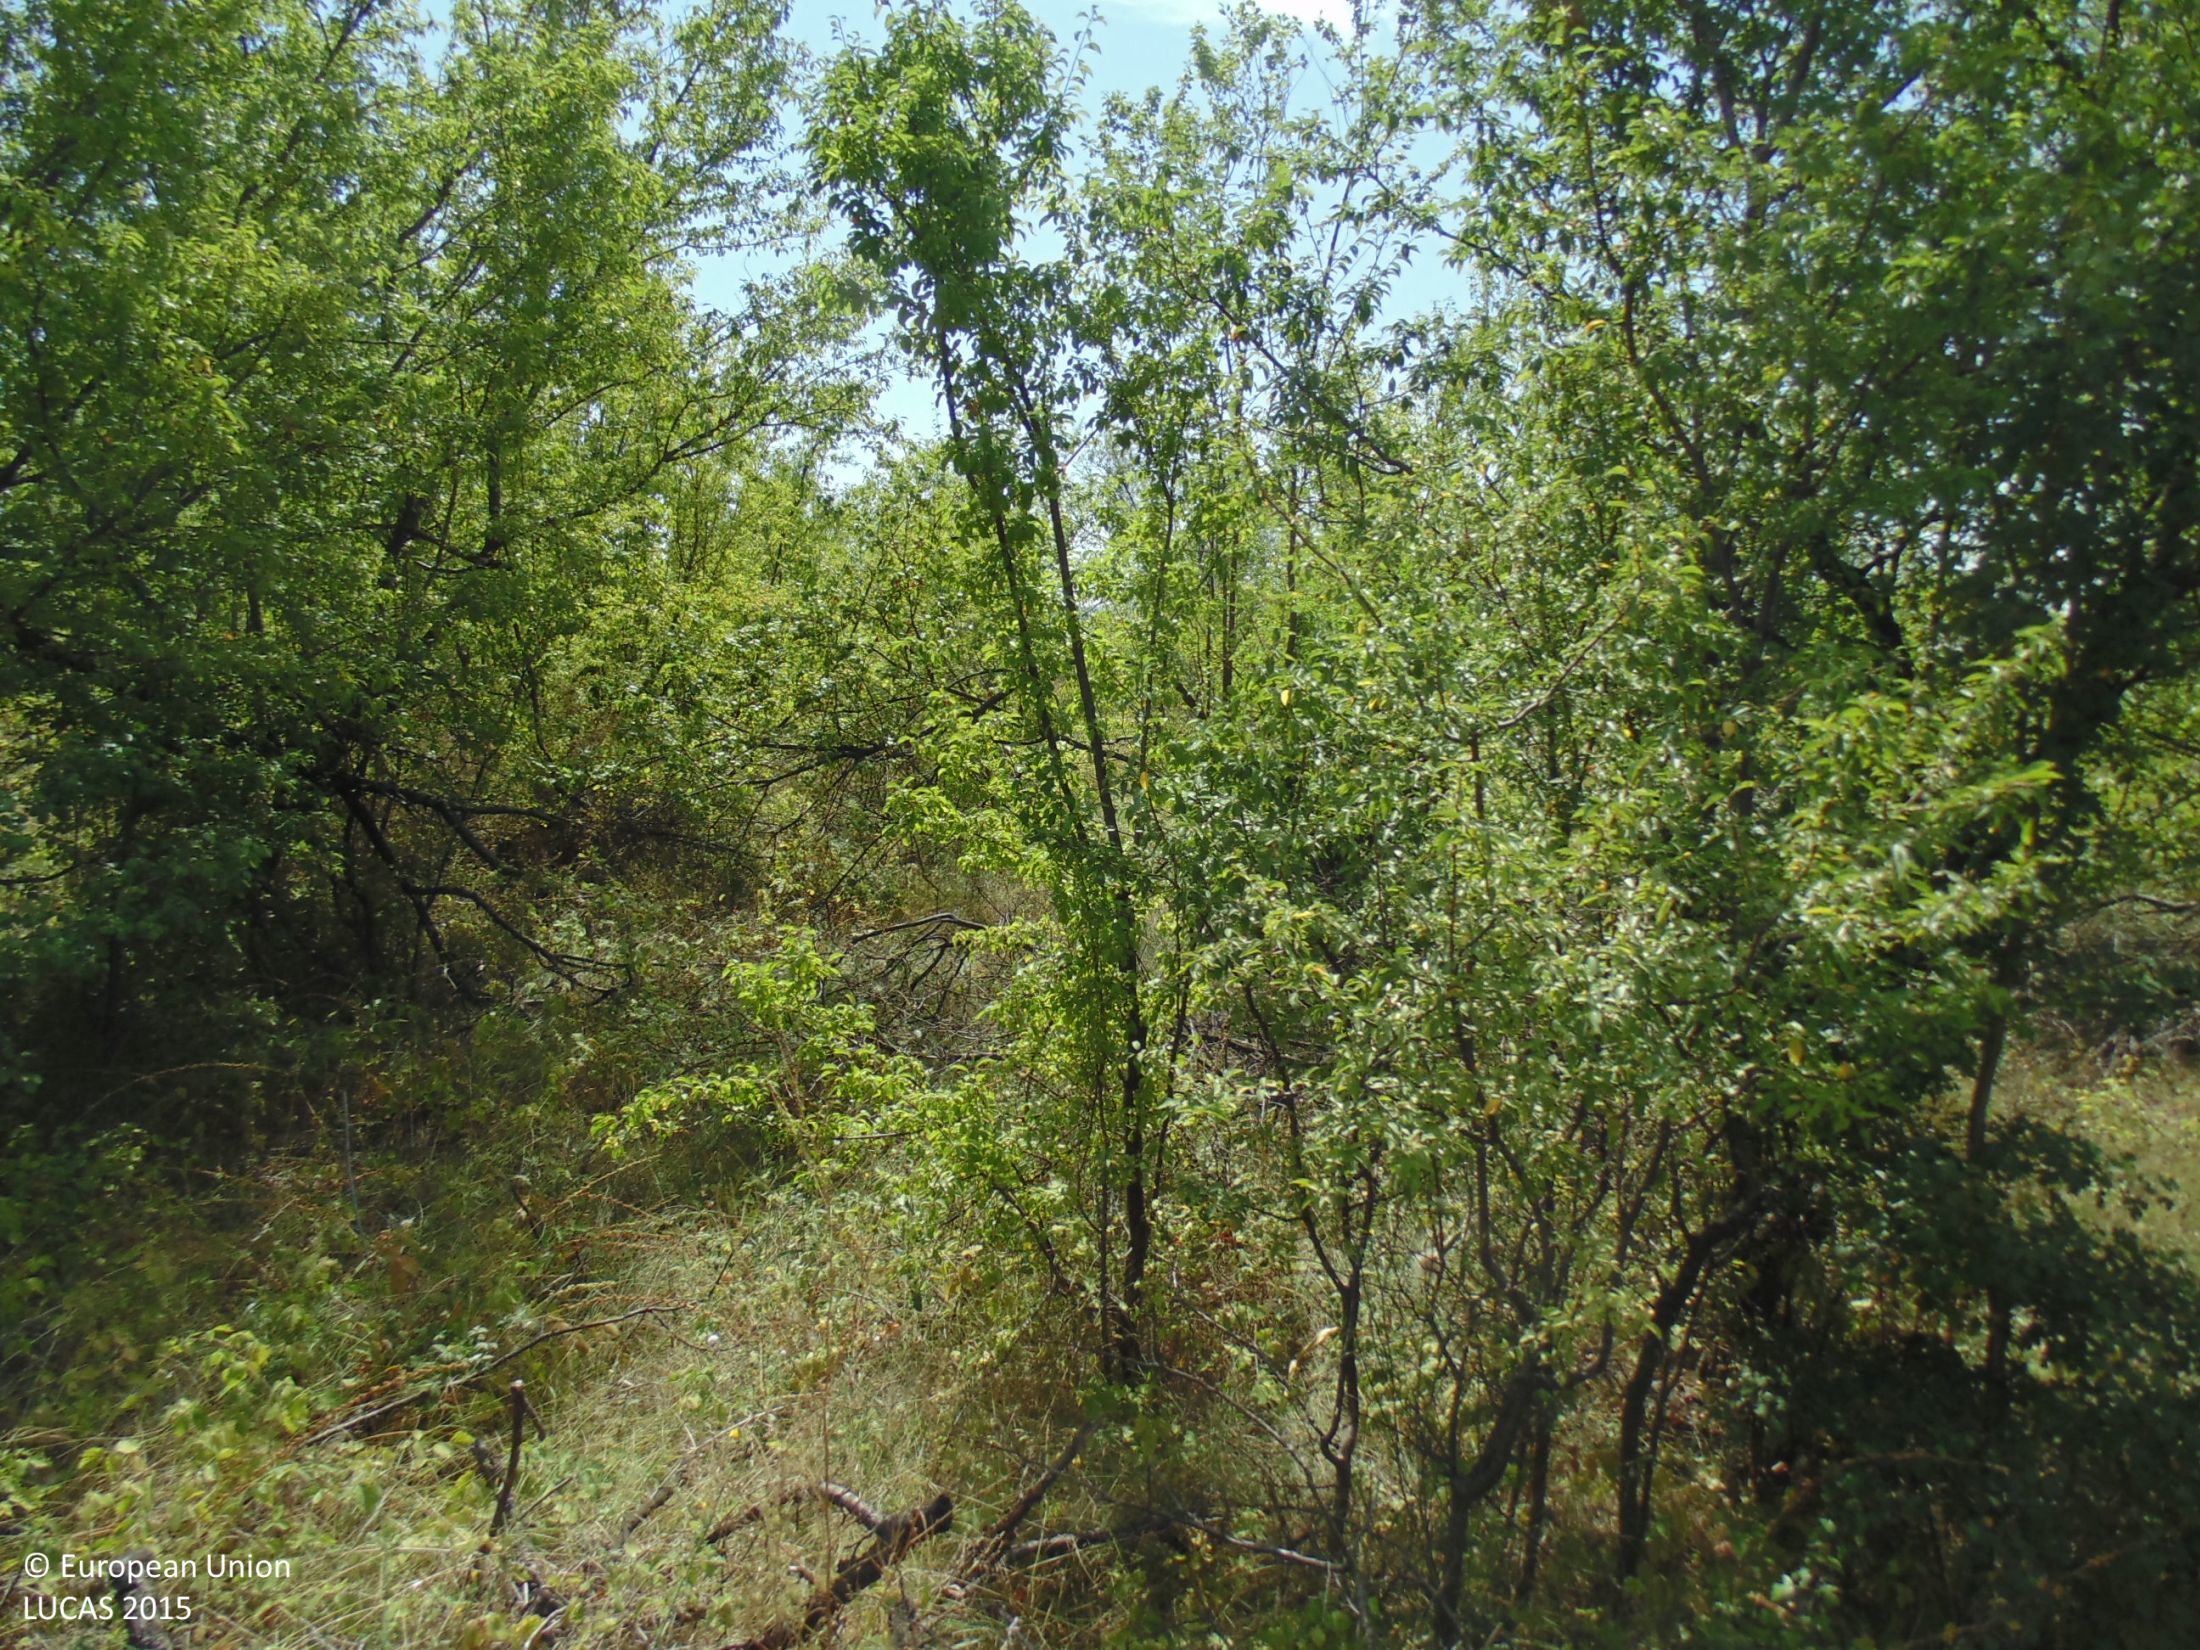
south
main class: Cropland
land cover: Other fruit trees and berries
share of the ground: 50 - 75 %
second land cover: Grassland without tree/shrub cover
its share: > 75 %
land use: Abandoned areas
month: September
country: BG
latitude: 43.8991
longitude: 27.0681
